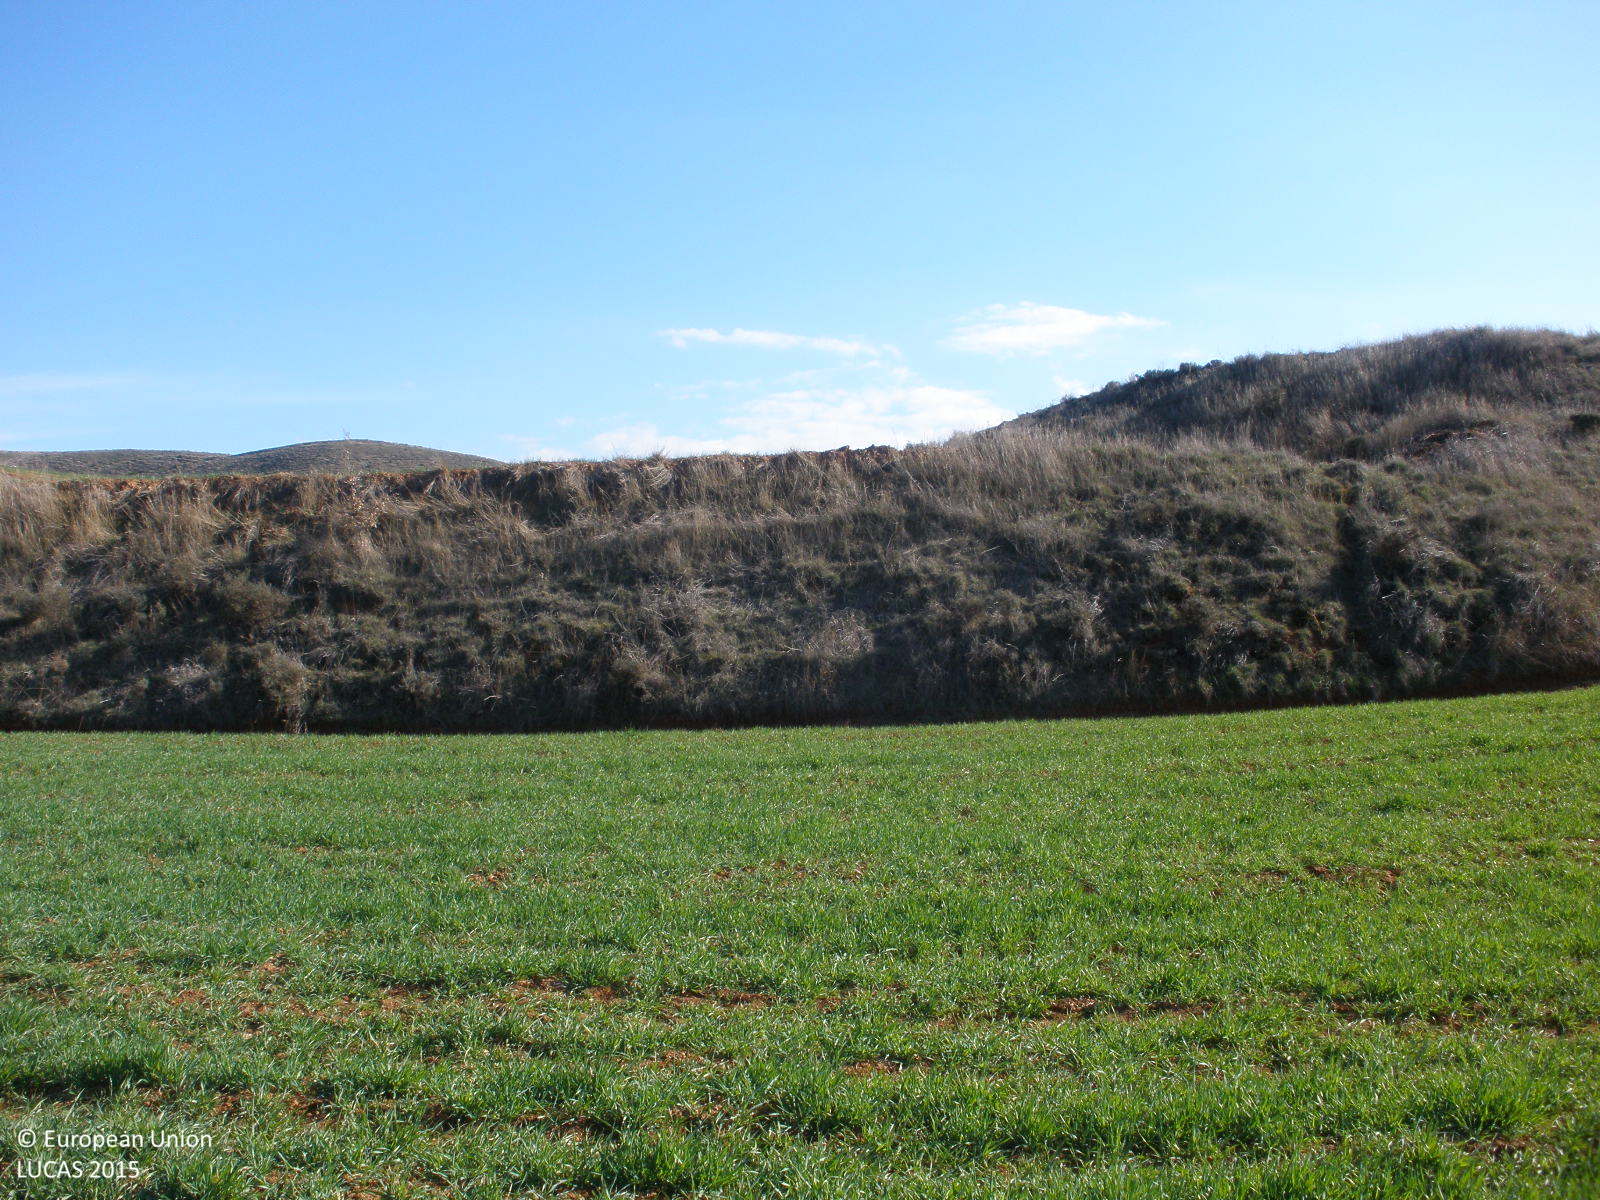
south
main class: Cropland
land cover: Barley
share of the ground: > 75 %
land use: Agriculture (excluding fallow land and kitchen gardens)
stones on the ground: < 10 %
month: April
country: ES
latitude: 40.9103
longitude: -1.1172
